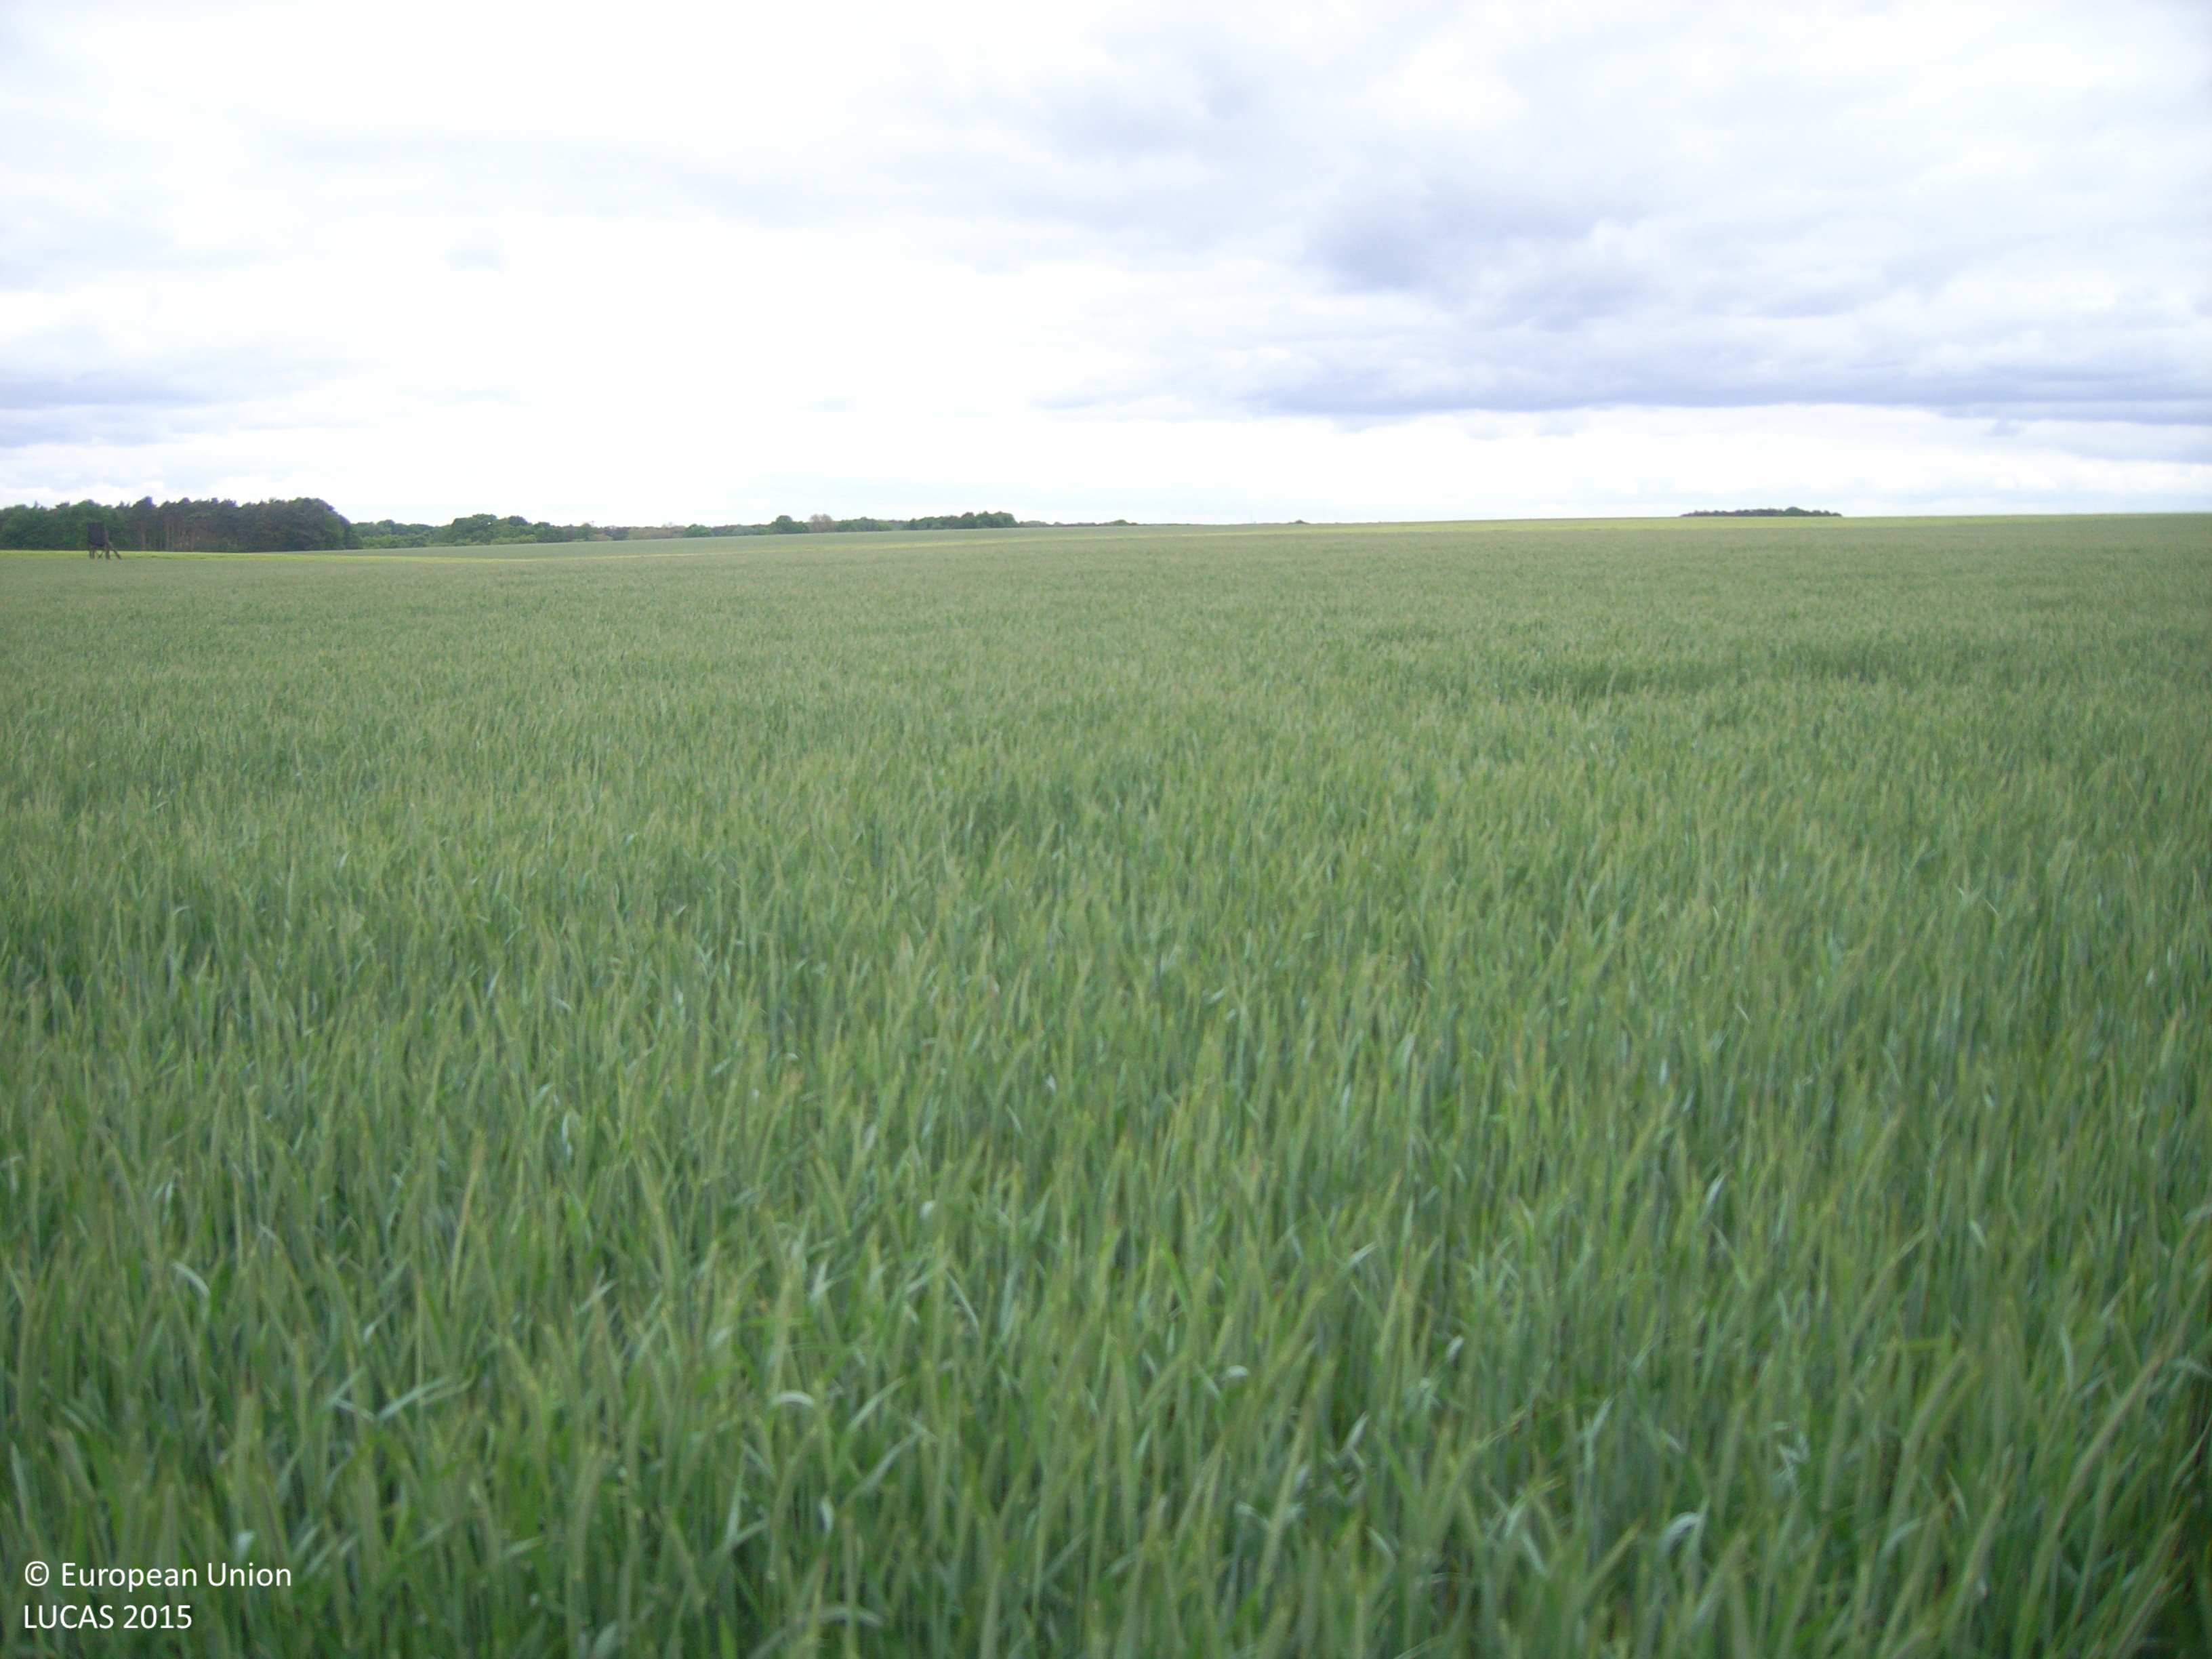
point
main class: Cropland
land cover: Rye
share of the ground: > 75 %
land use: Agriculture (excluding fallow land and kitchen gardens)
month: May
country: DE
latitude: 52.2513
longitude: 13.5892
